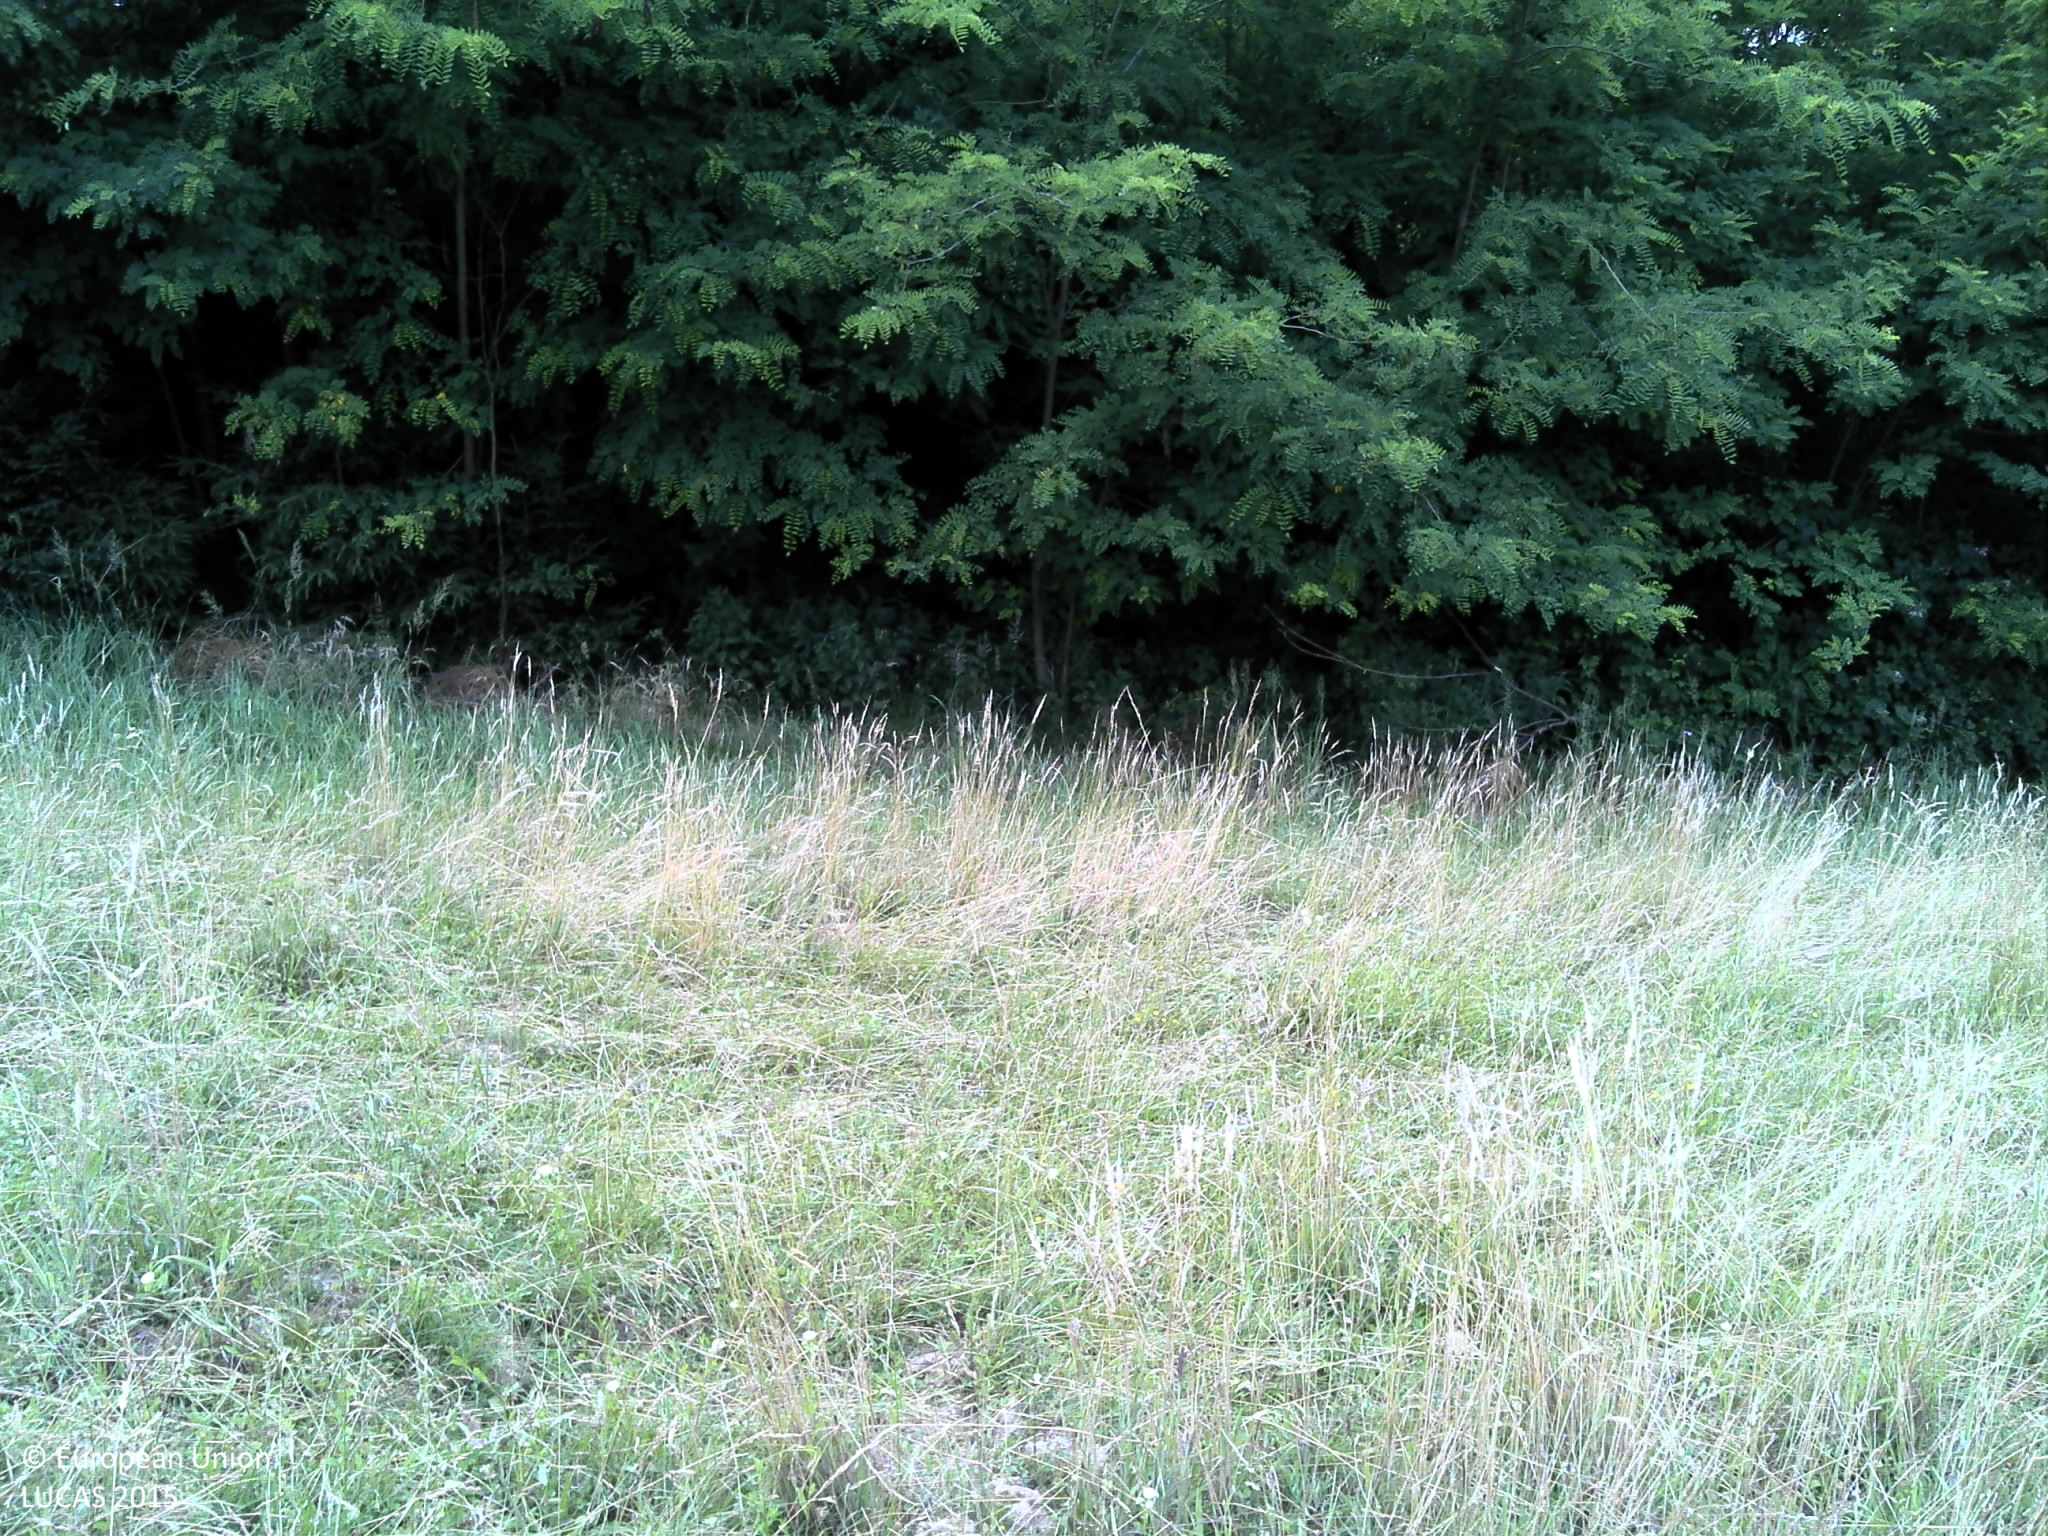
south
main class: Grassland
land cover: Grassland without tree/shrub cover
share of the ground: > 75 %
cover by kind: herbaceous plants 100 %
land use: Agriculture (excluding fallow land and kitchen gardens)
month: June
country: HR
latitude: 45.7640
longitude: 17.4728
